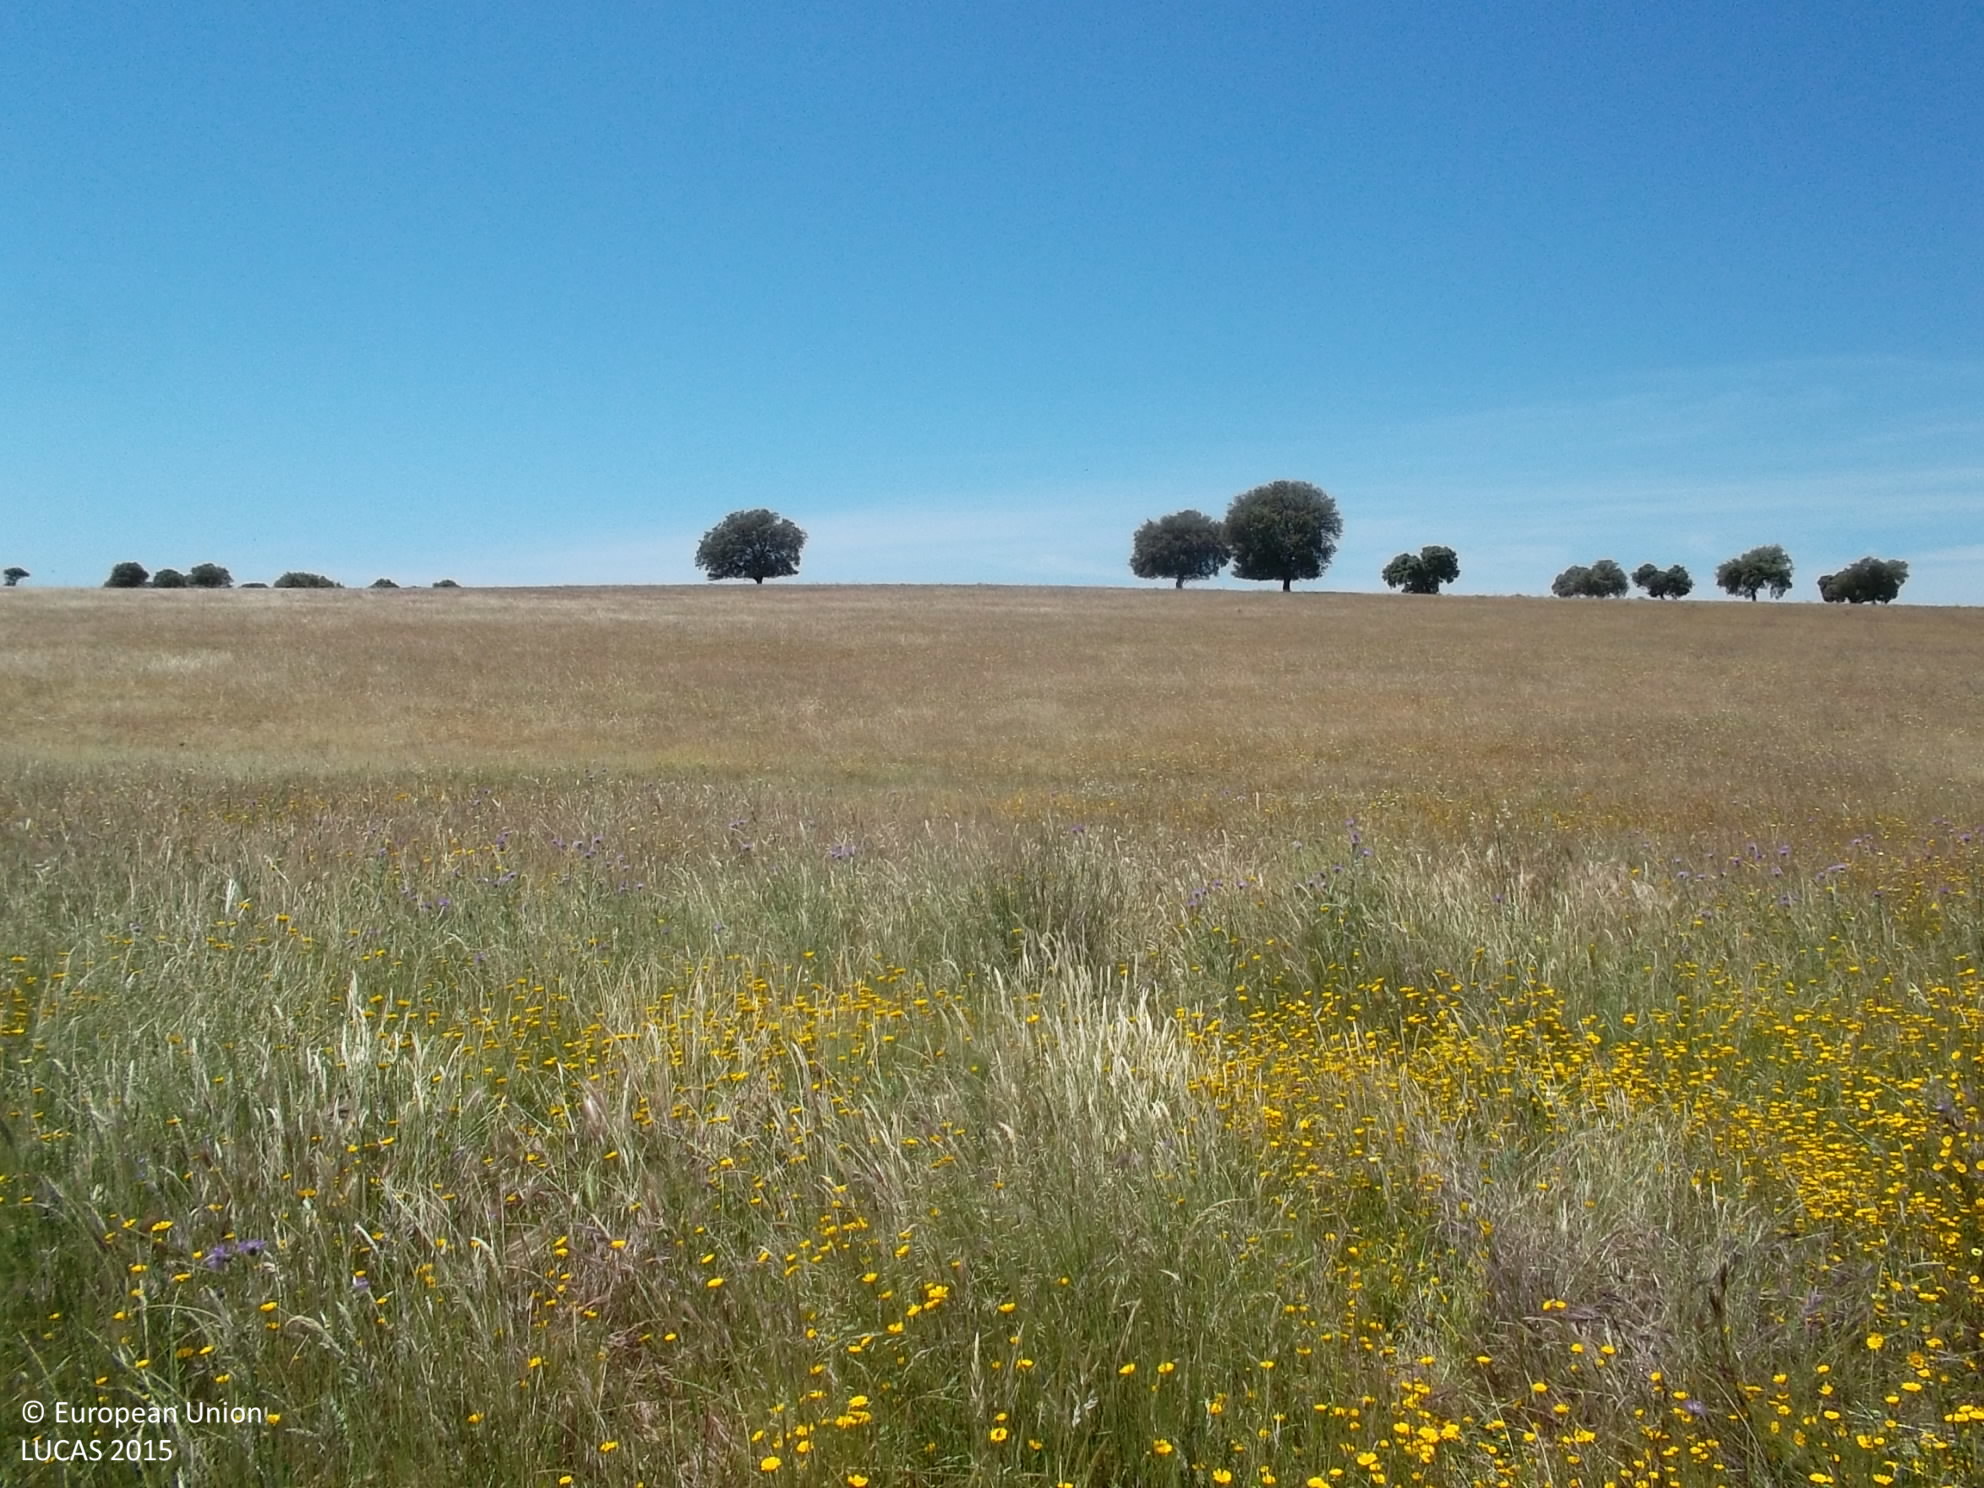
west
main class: Grassland
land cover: Grassland with sparse tree/shrub cover
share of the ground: > 75 %
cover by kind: herbaceous plants 95 %, broadleaved forest trees 5 %
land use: Agriculture (excluding fallow land and kitchen gardens)
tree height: > 5 m
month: May
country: ES
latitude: 38.8976
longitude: -4.4502
